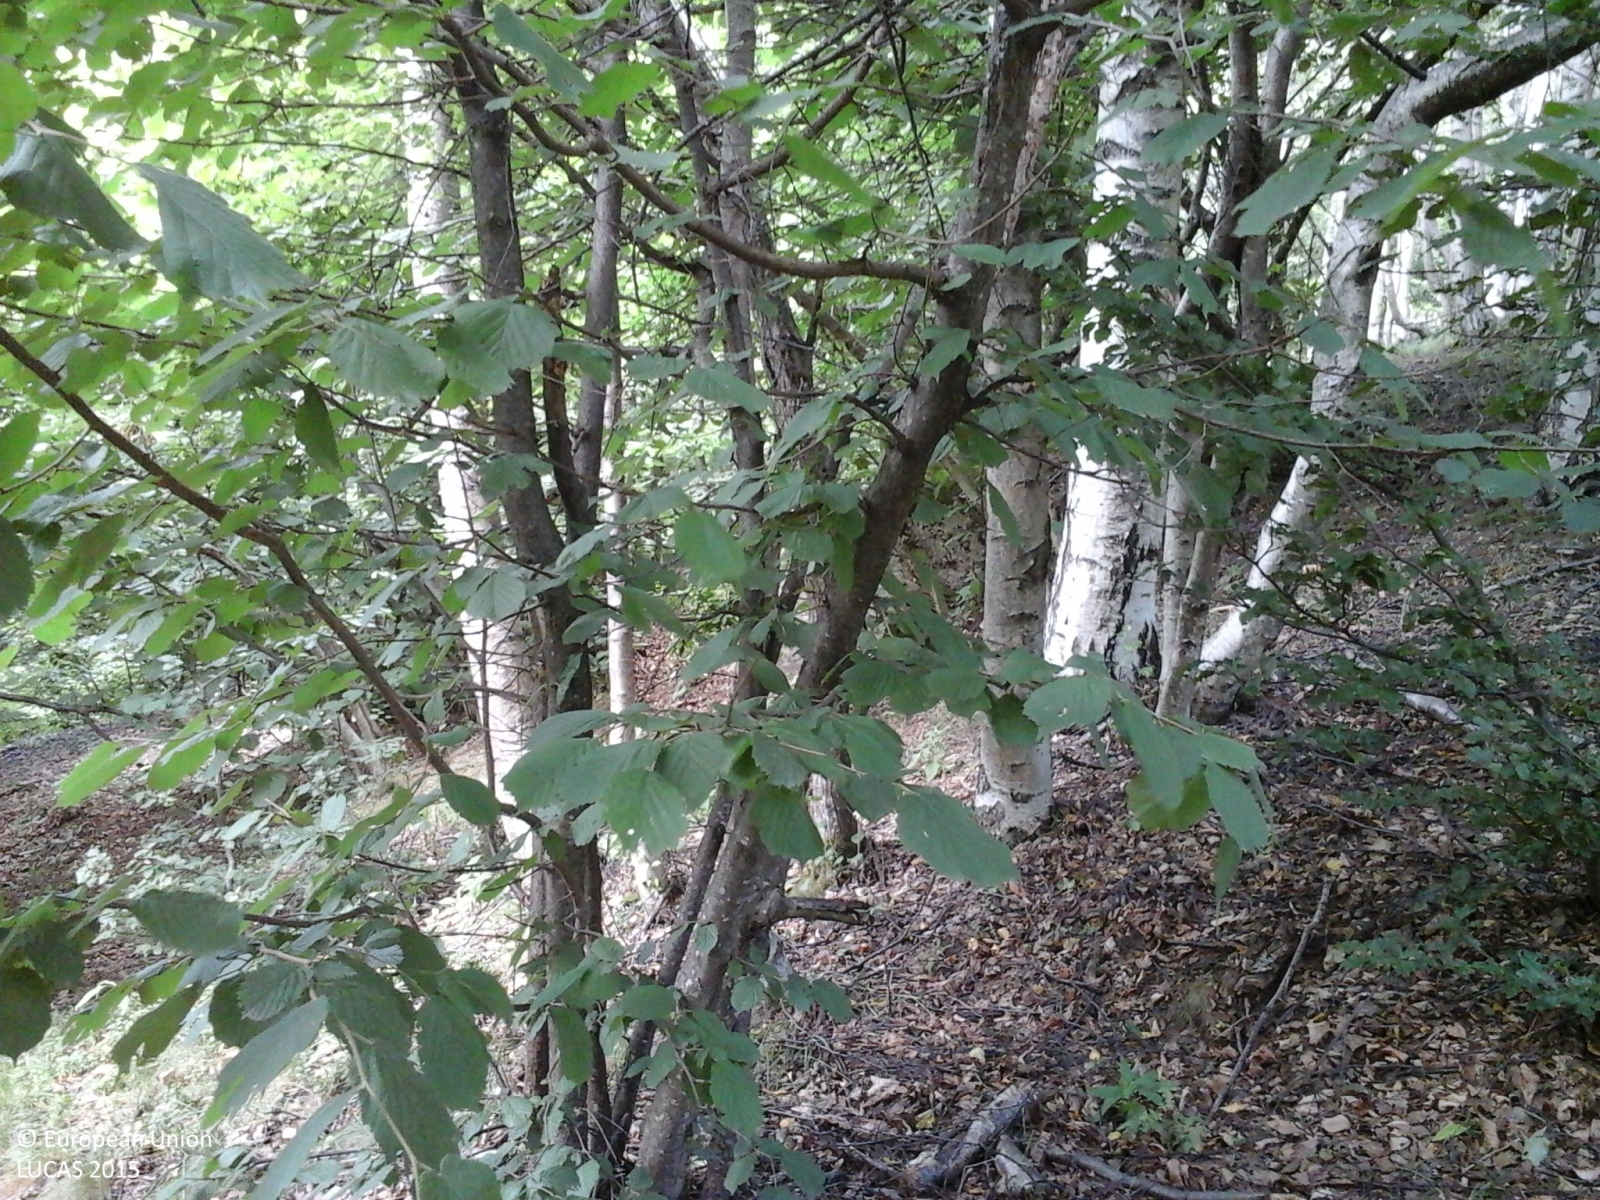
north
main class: Woodland
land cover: Broadleaved woodland
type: mountainous beech forest
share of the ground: > 75 %
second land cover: Grassland without tree/shrub cover
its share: > 75 %
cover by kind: broadleaved forest trees 70 %, herbaceous plants 30 %
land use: Forestry
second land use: Agriculture (excluding fallow land and kitchen gardens)
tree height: > 5 m
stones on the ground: < 10 %
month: July
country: IT
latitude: 44.6741
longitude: 7.2174
